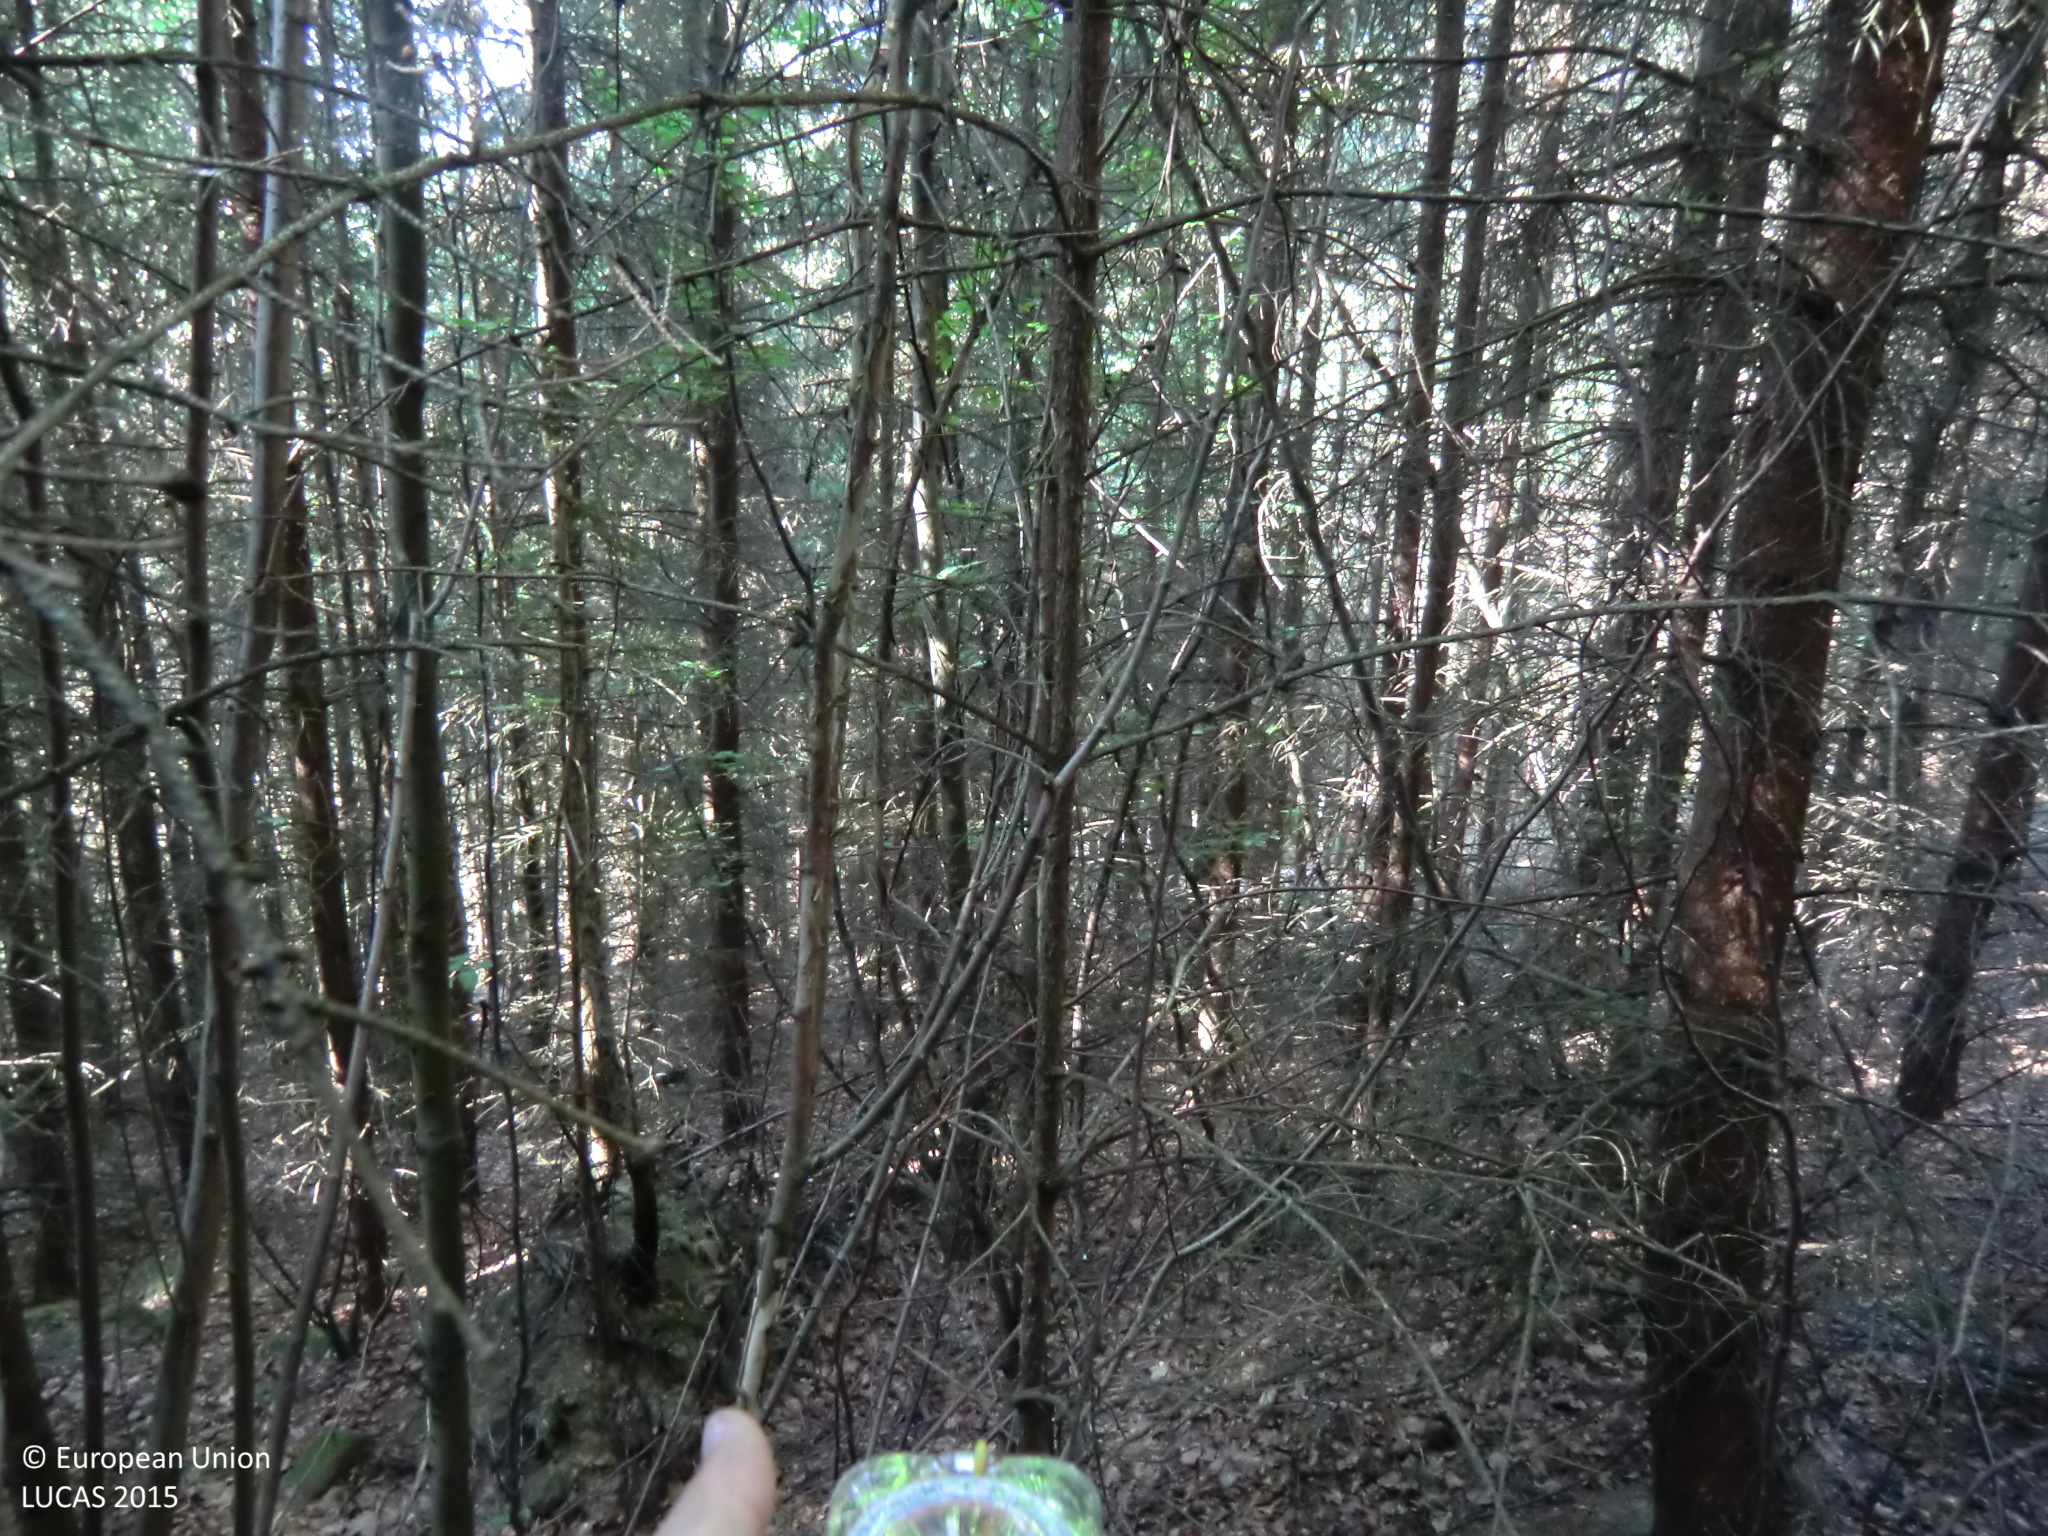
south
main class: Woodland
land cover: Spruce dominated coniferous woodland
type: alpine coniferous forest
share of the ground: > 75 %
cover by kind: coniferous forest trees 90 %, broadleaved forest trees 5 %, consolidated bare surface 5 %
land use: Forestry
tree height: > 5 m
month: June
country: AT
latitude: 48.4592
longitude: 14.4225
